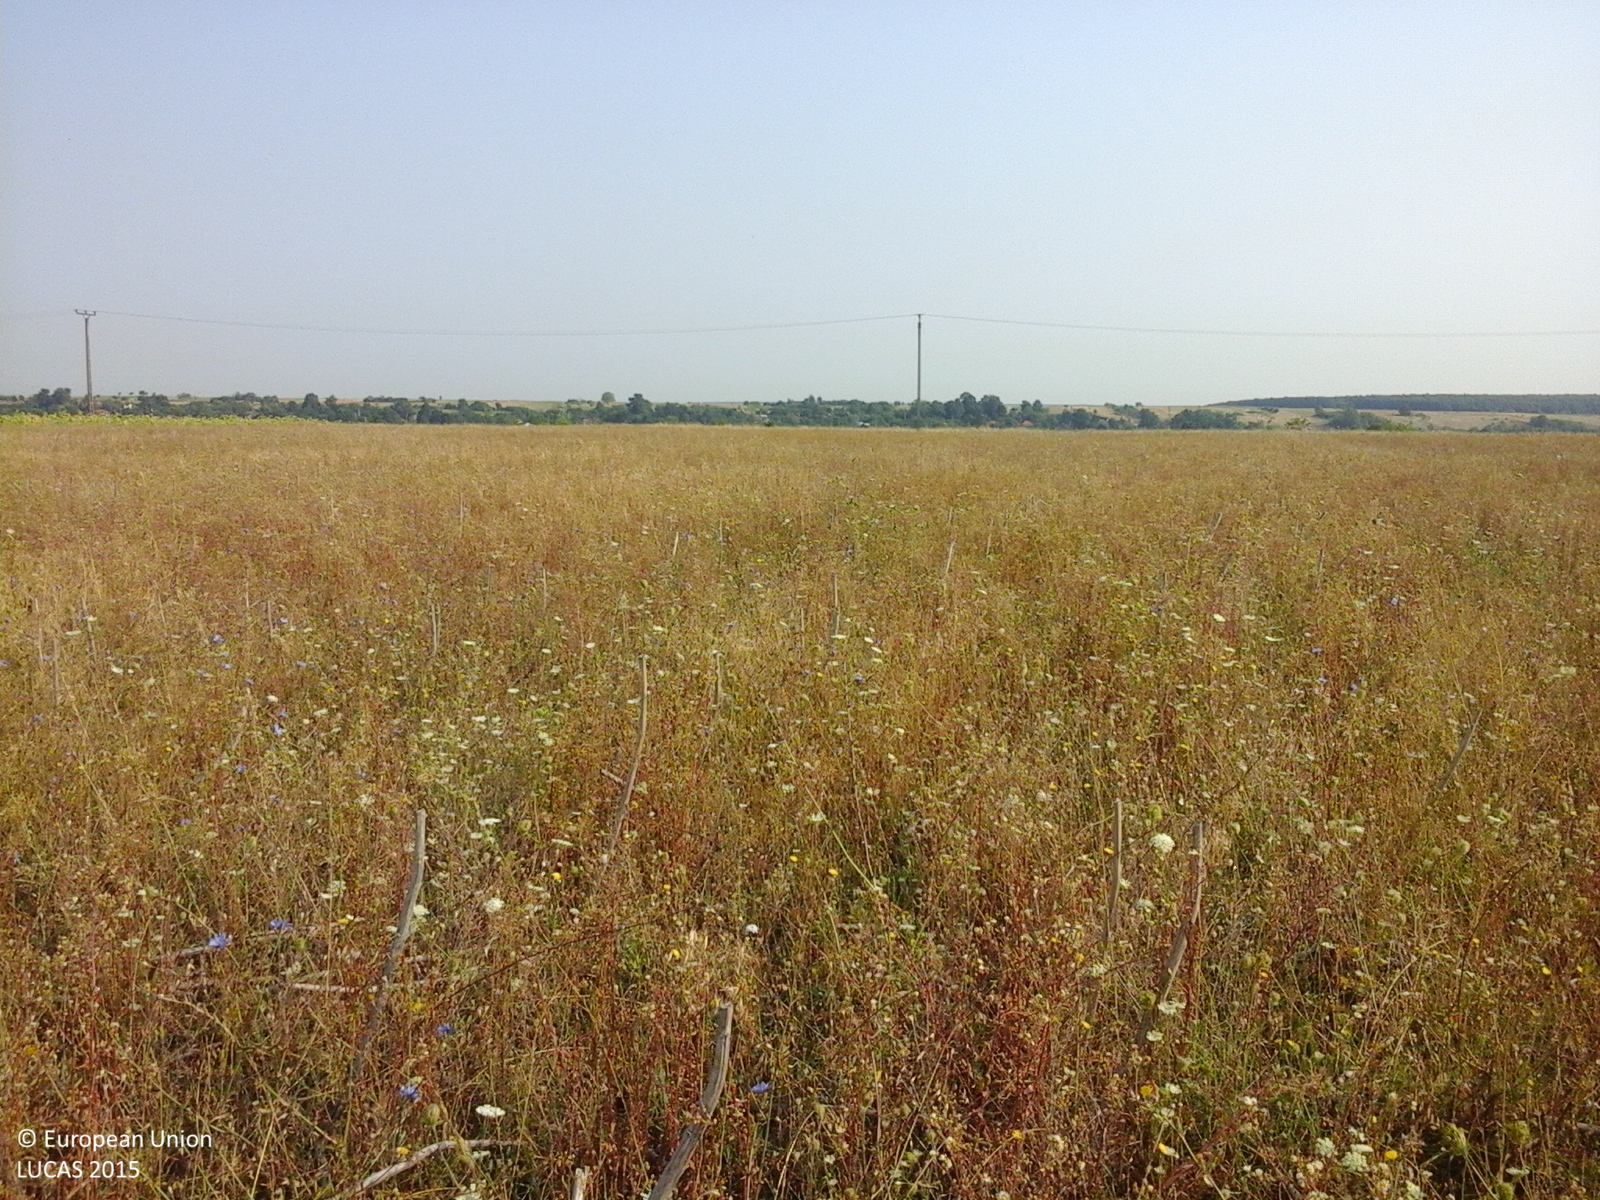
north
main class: Grassland
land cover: Spontaneously vegetated surfaces
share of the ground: > 75 %
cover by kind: herbaceous plants 100 %
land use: Fallow land
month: August
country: RO
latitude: 44.4725
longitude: 23.1849
